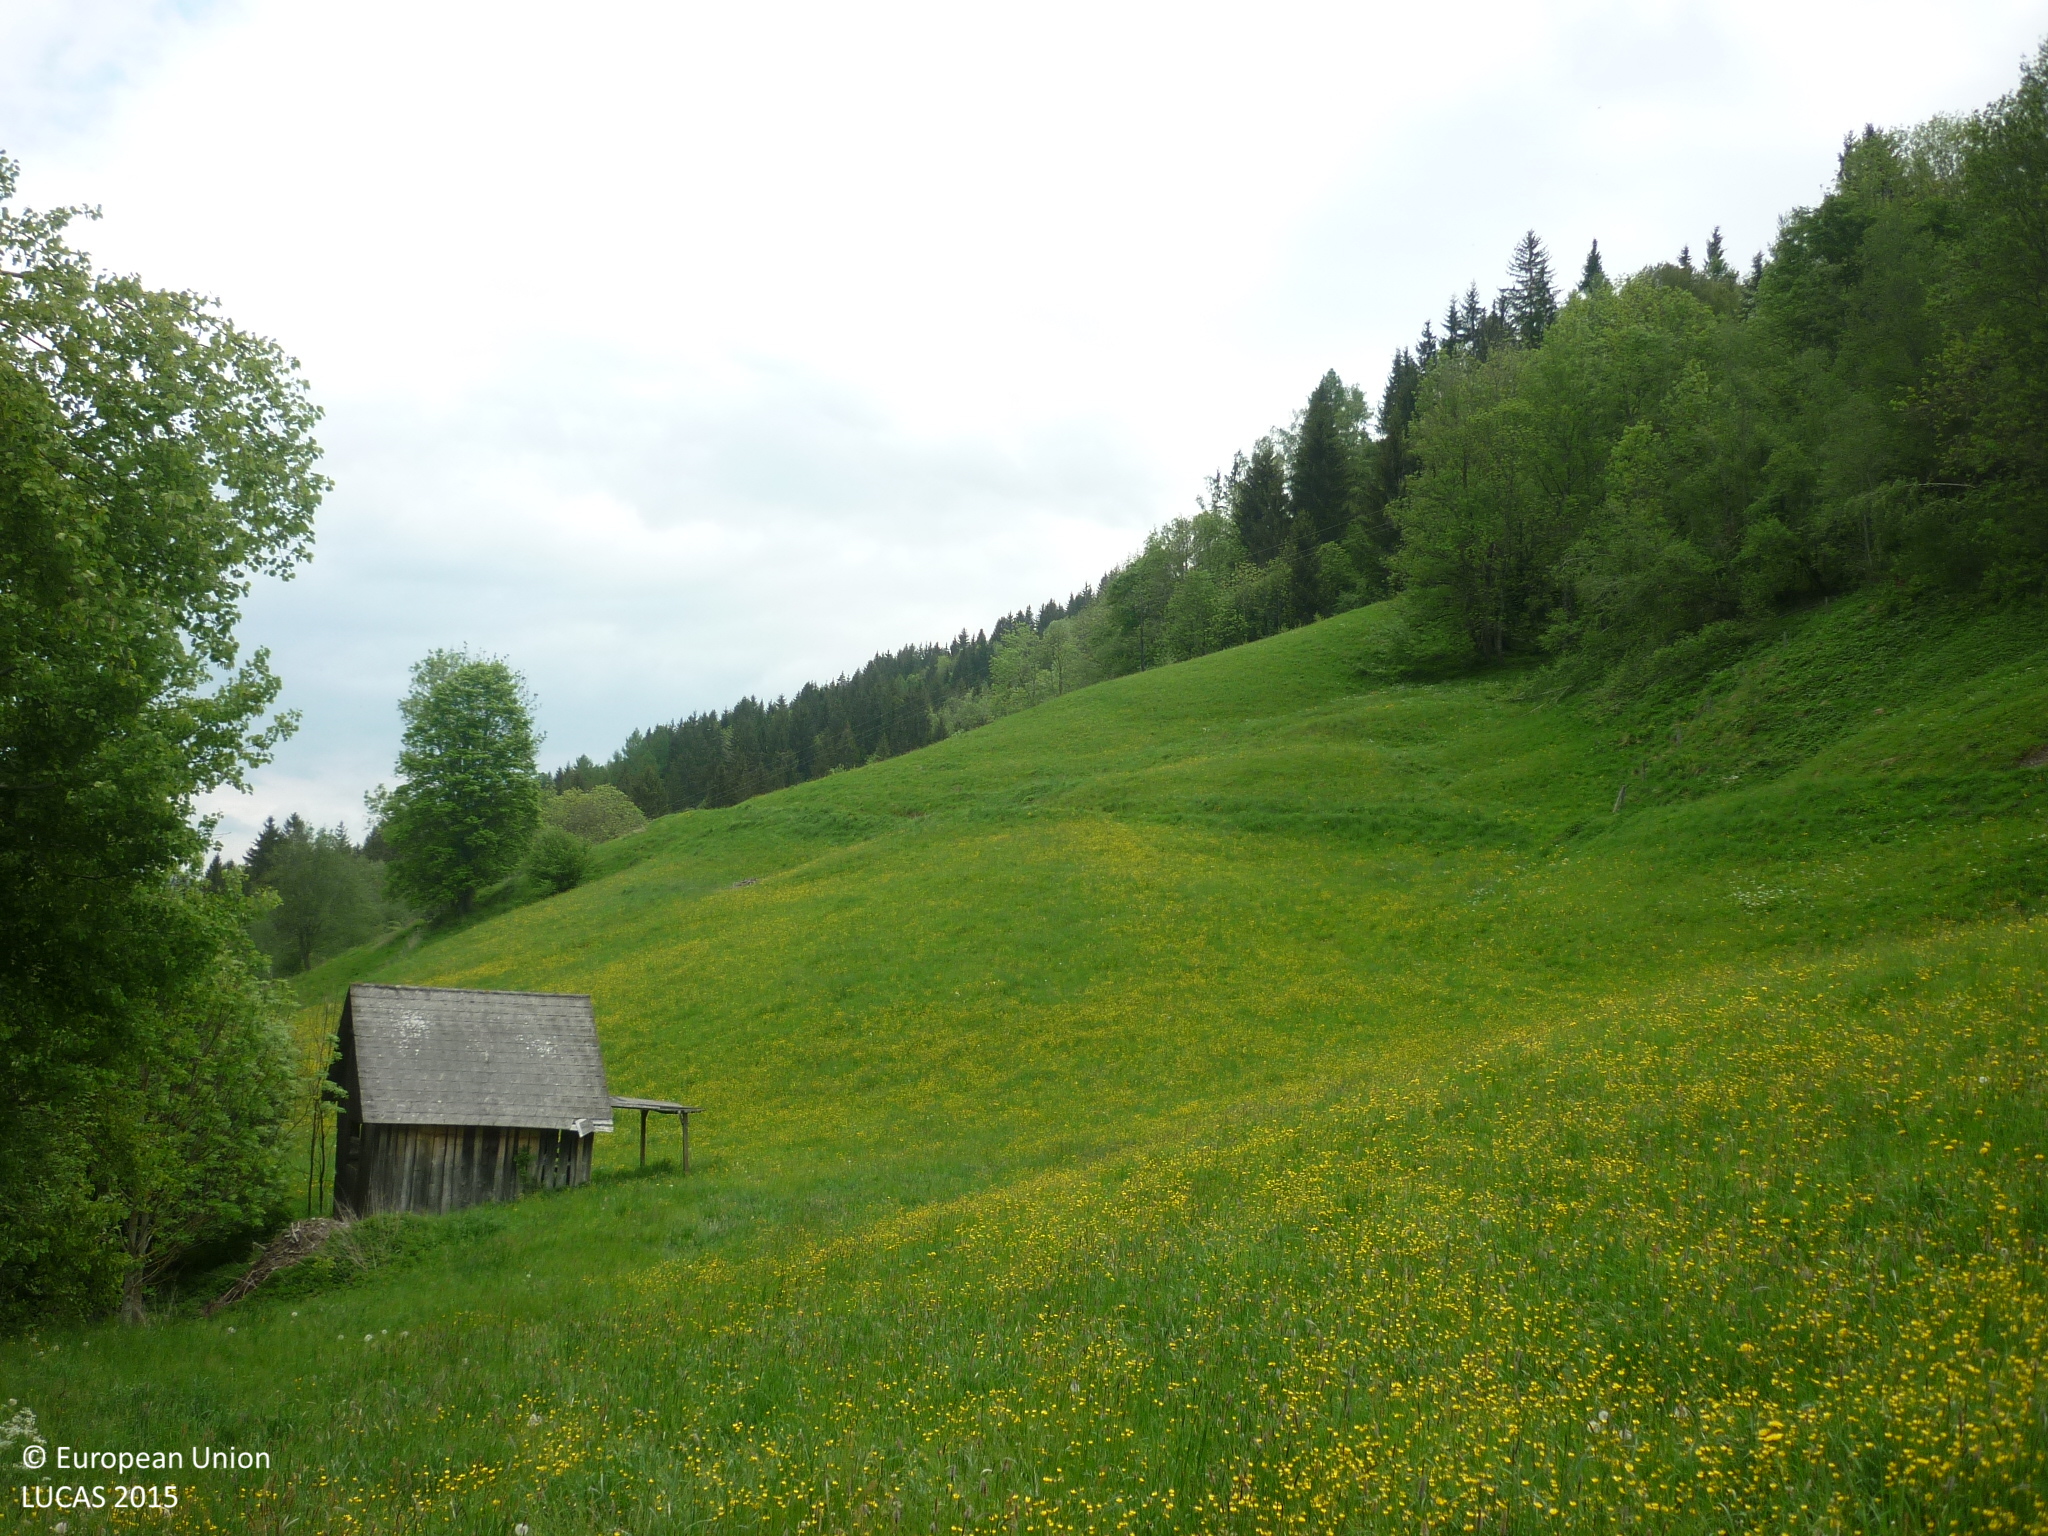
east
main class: Grassland
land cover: Grassland without tree/shrub cover
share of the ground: > 75 %
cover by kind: herbaceous plants 100 %
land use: Agriculture (excluding fallow land and kitchen gardens)
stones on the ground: < 10 %
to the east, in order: Grassland without tree/shrub cover; Tracks; Grassland without tree/shrub cover; Electric lines; Grassland without tree/shrub cover
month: May
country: AT
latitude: 47.4031
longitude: 13.7484
